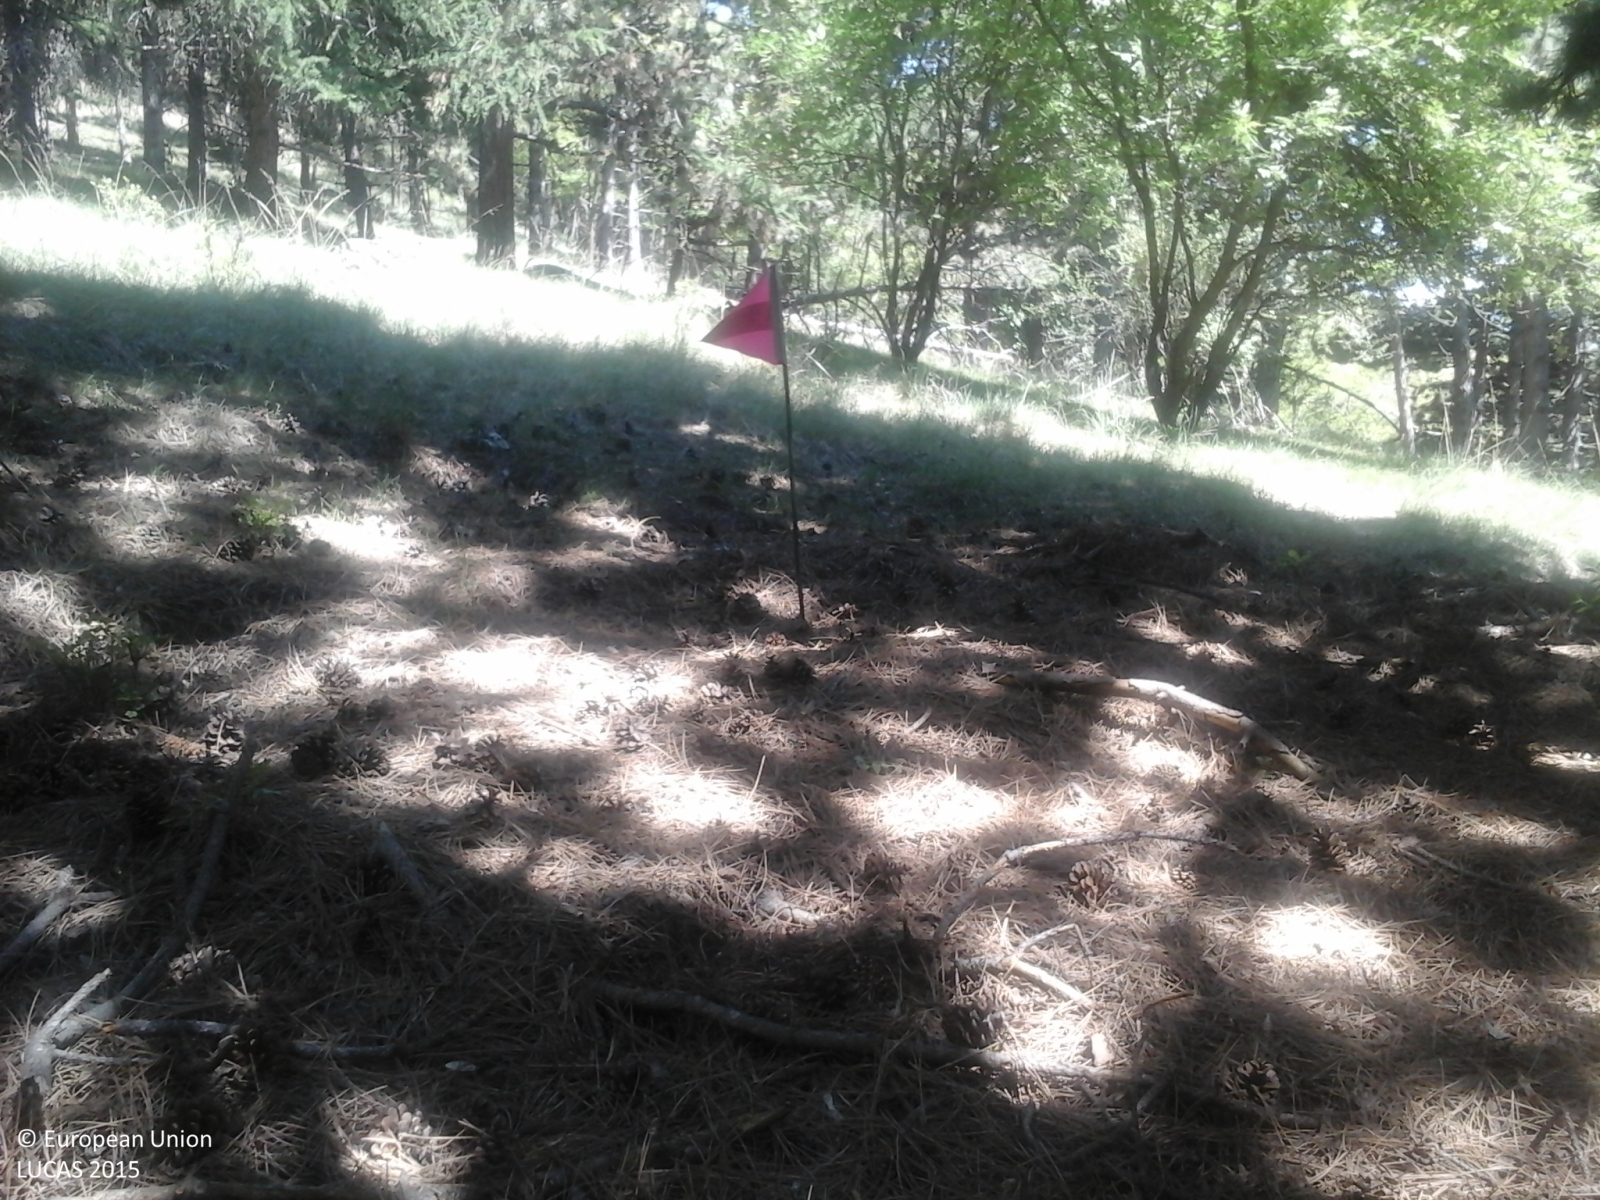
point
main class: Woodland
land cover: Pine dominated mixed woodland
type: alpine coniferous forest
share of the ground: > 75 %
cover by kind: coniferous forest trees 70 %, broadleaved forest trees 30 %
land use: Forestry
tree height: > 5 m
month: May
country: IT
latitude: 46.6376
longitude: 10.6132
